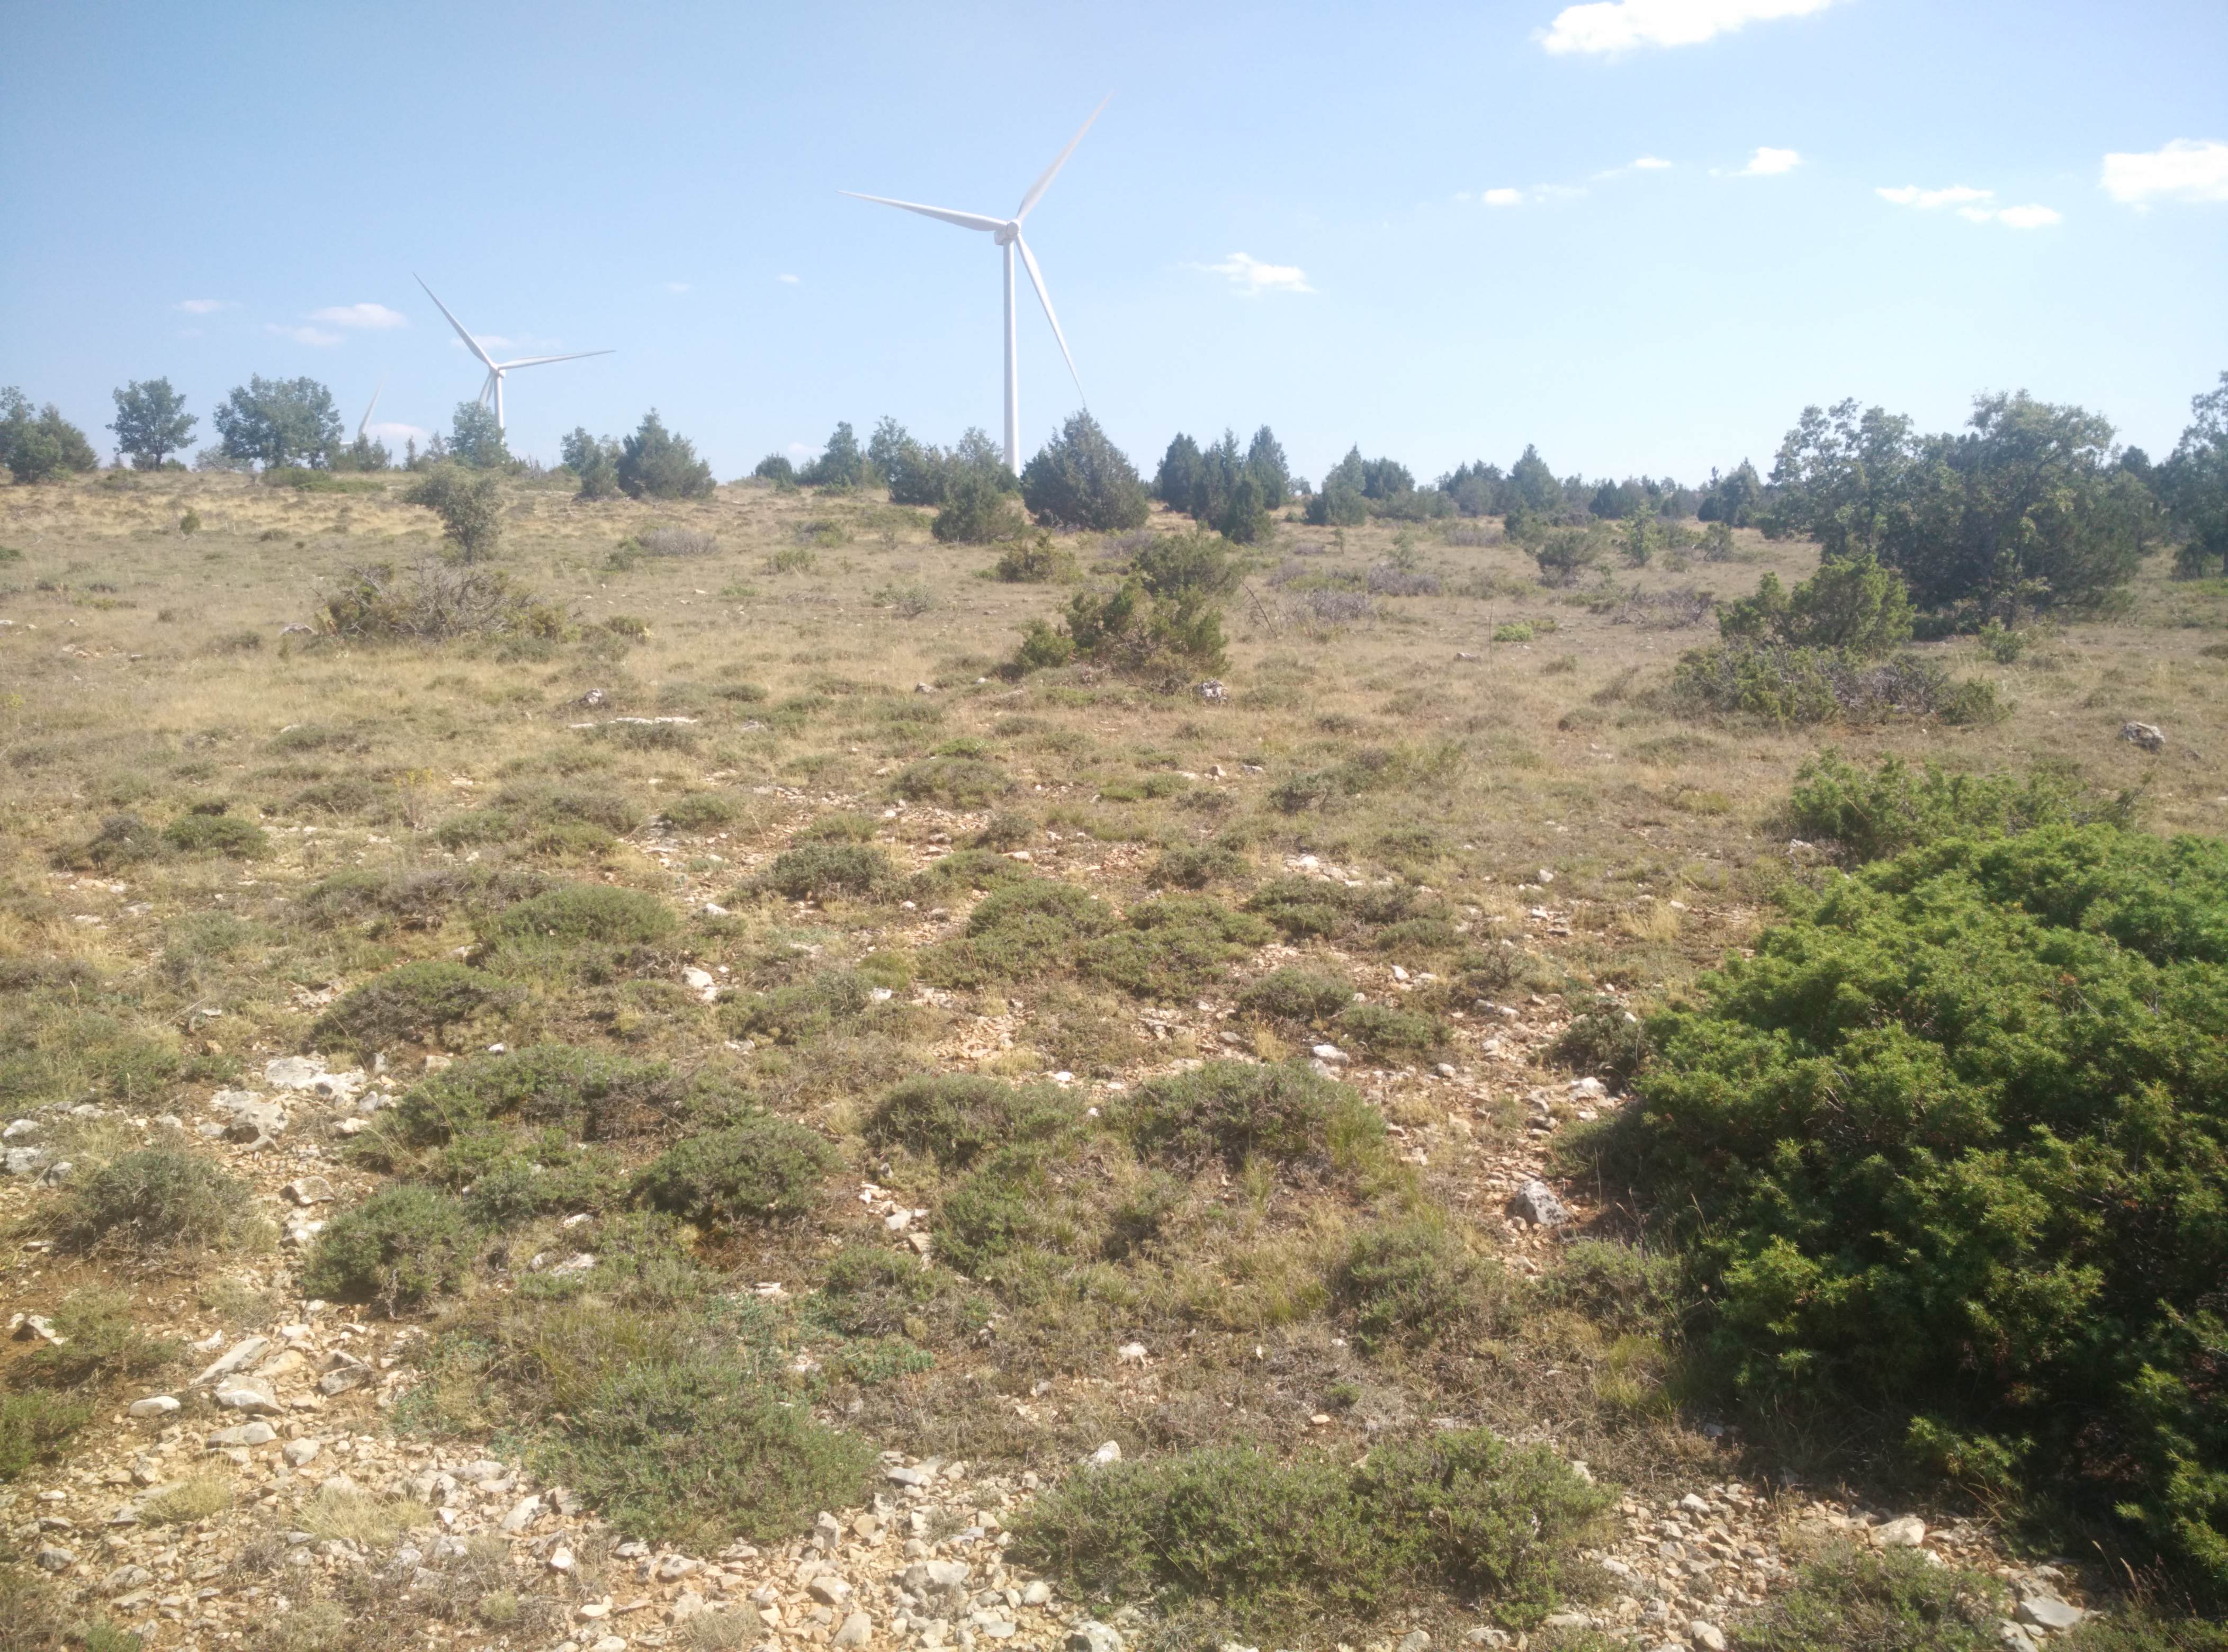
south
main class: Shrubland
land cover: Shrubland with sparse tree cover
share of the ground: 25 - 50 %
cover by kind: shrubs 40 %, herbaceous plants 35 %, unconsolidated bare surface 20 %, coniferous forest trees 5 %
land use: Semi-natural and natural areas not in use
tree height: > 5 m
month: July
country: ES
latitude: 41.0616
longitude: -2.1528
